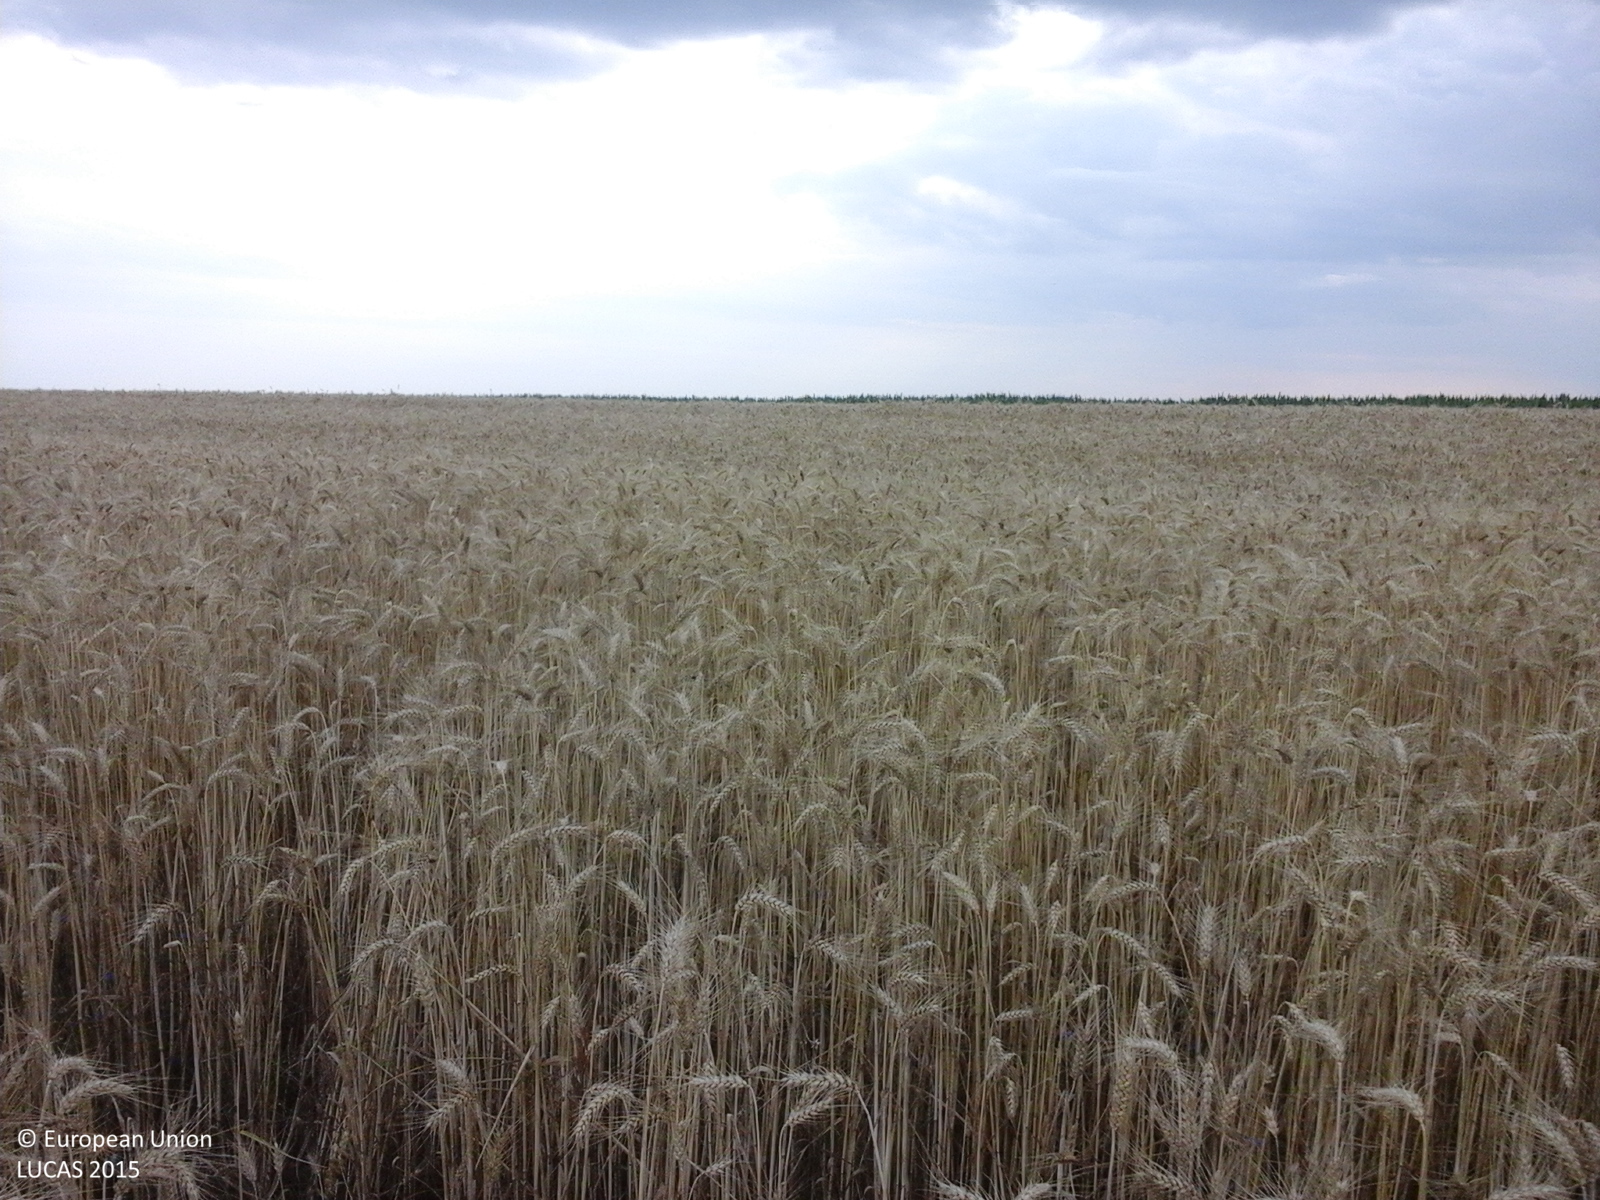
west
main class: Cropland
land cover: Common wheat
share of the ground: > 75 %
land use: Agriculture (excluding fallow land and kitchen gardens)
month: June
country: RO
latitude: 44.1494
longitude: 26.5538
